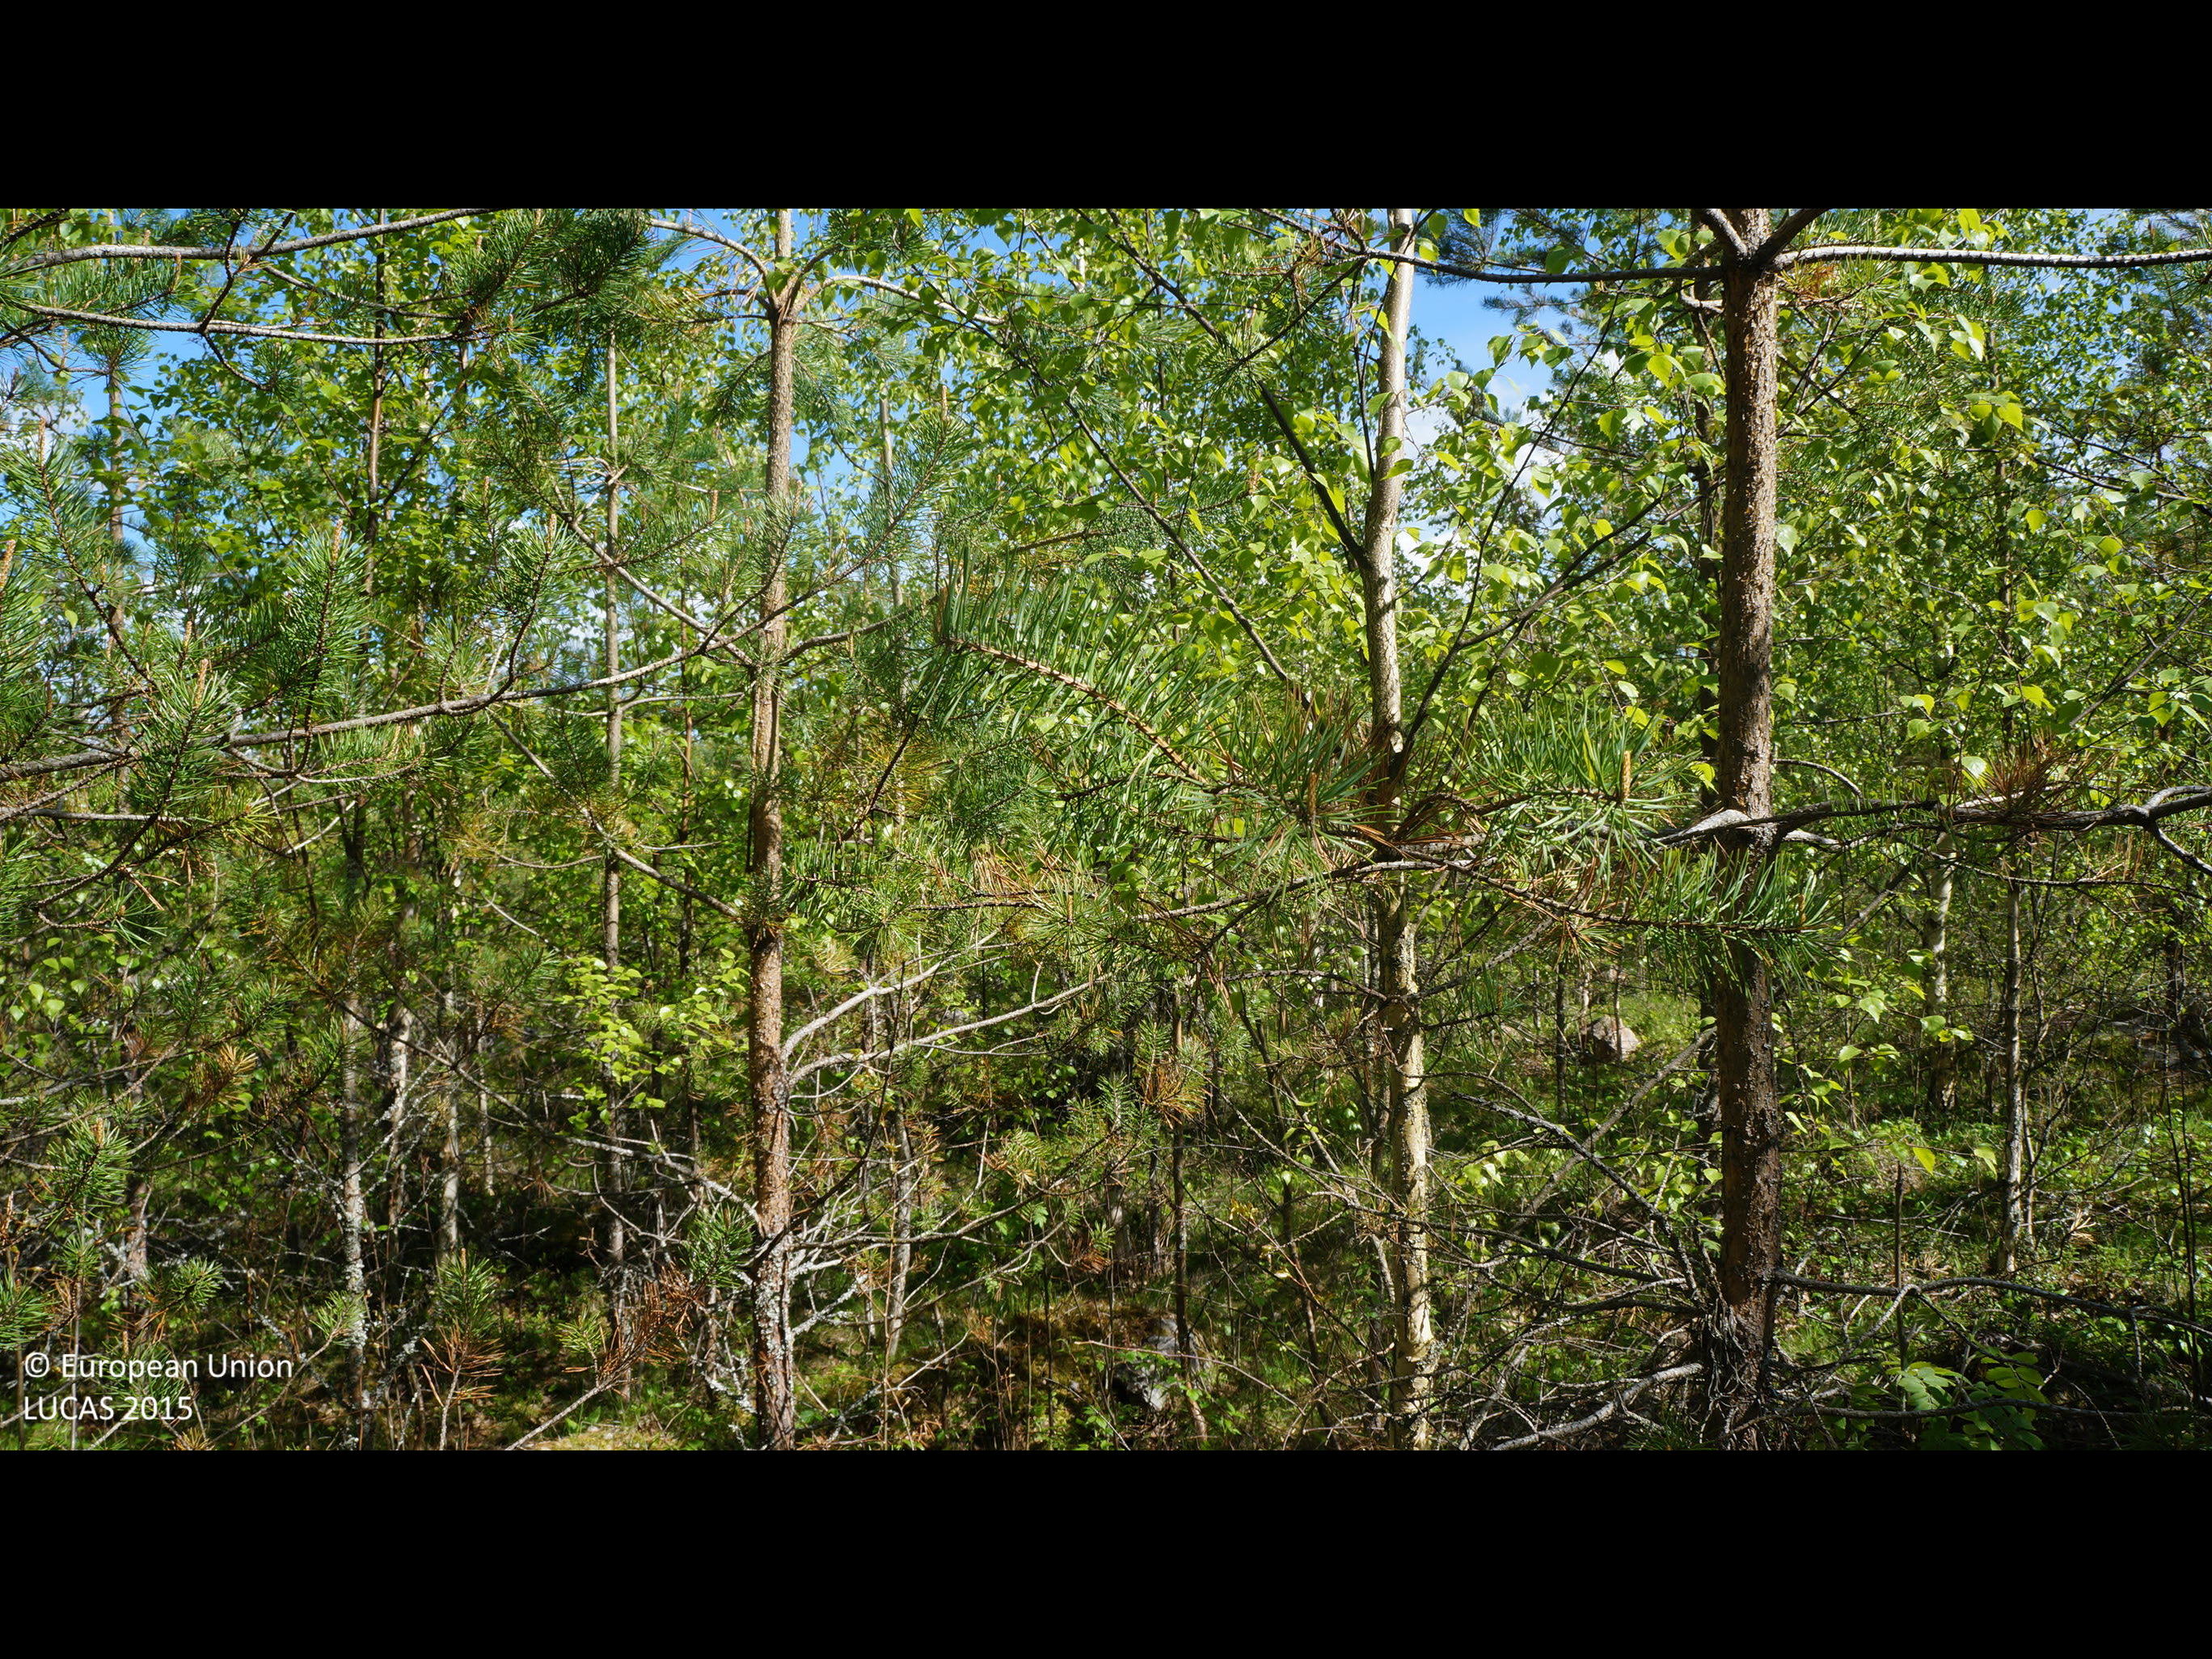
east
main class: Woodland
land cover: Other mixed woodland
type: boreal forest
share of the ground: > 75 %
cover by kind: coniferous forest trees 60 %, broadleaved forest trees 20 %, shrubs 20 %
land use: Forestry
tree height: > 5 m
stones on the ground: > 50 %
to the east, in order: Other mixed woodland; Shrubland without tree cover; Ditches and canals; Broadleaved woodland; Ditches and canals; Other mixed woodland; Ditches and canals; Other mixed woodland
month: June
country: FI
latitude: 63.7413
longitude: 23.3264
